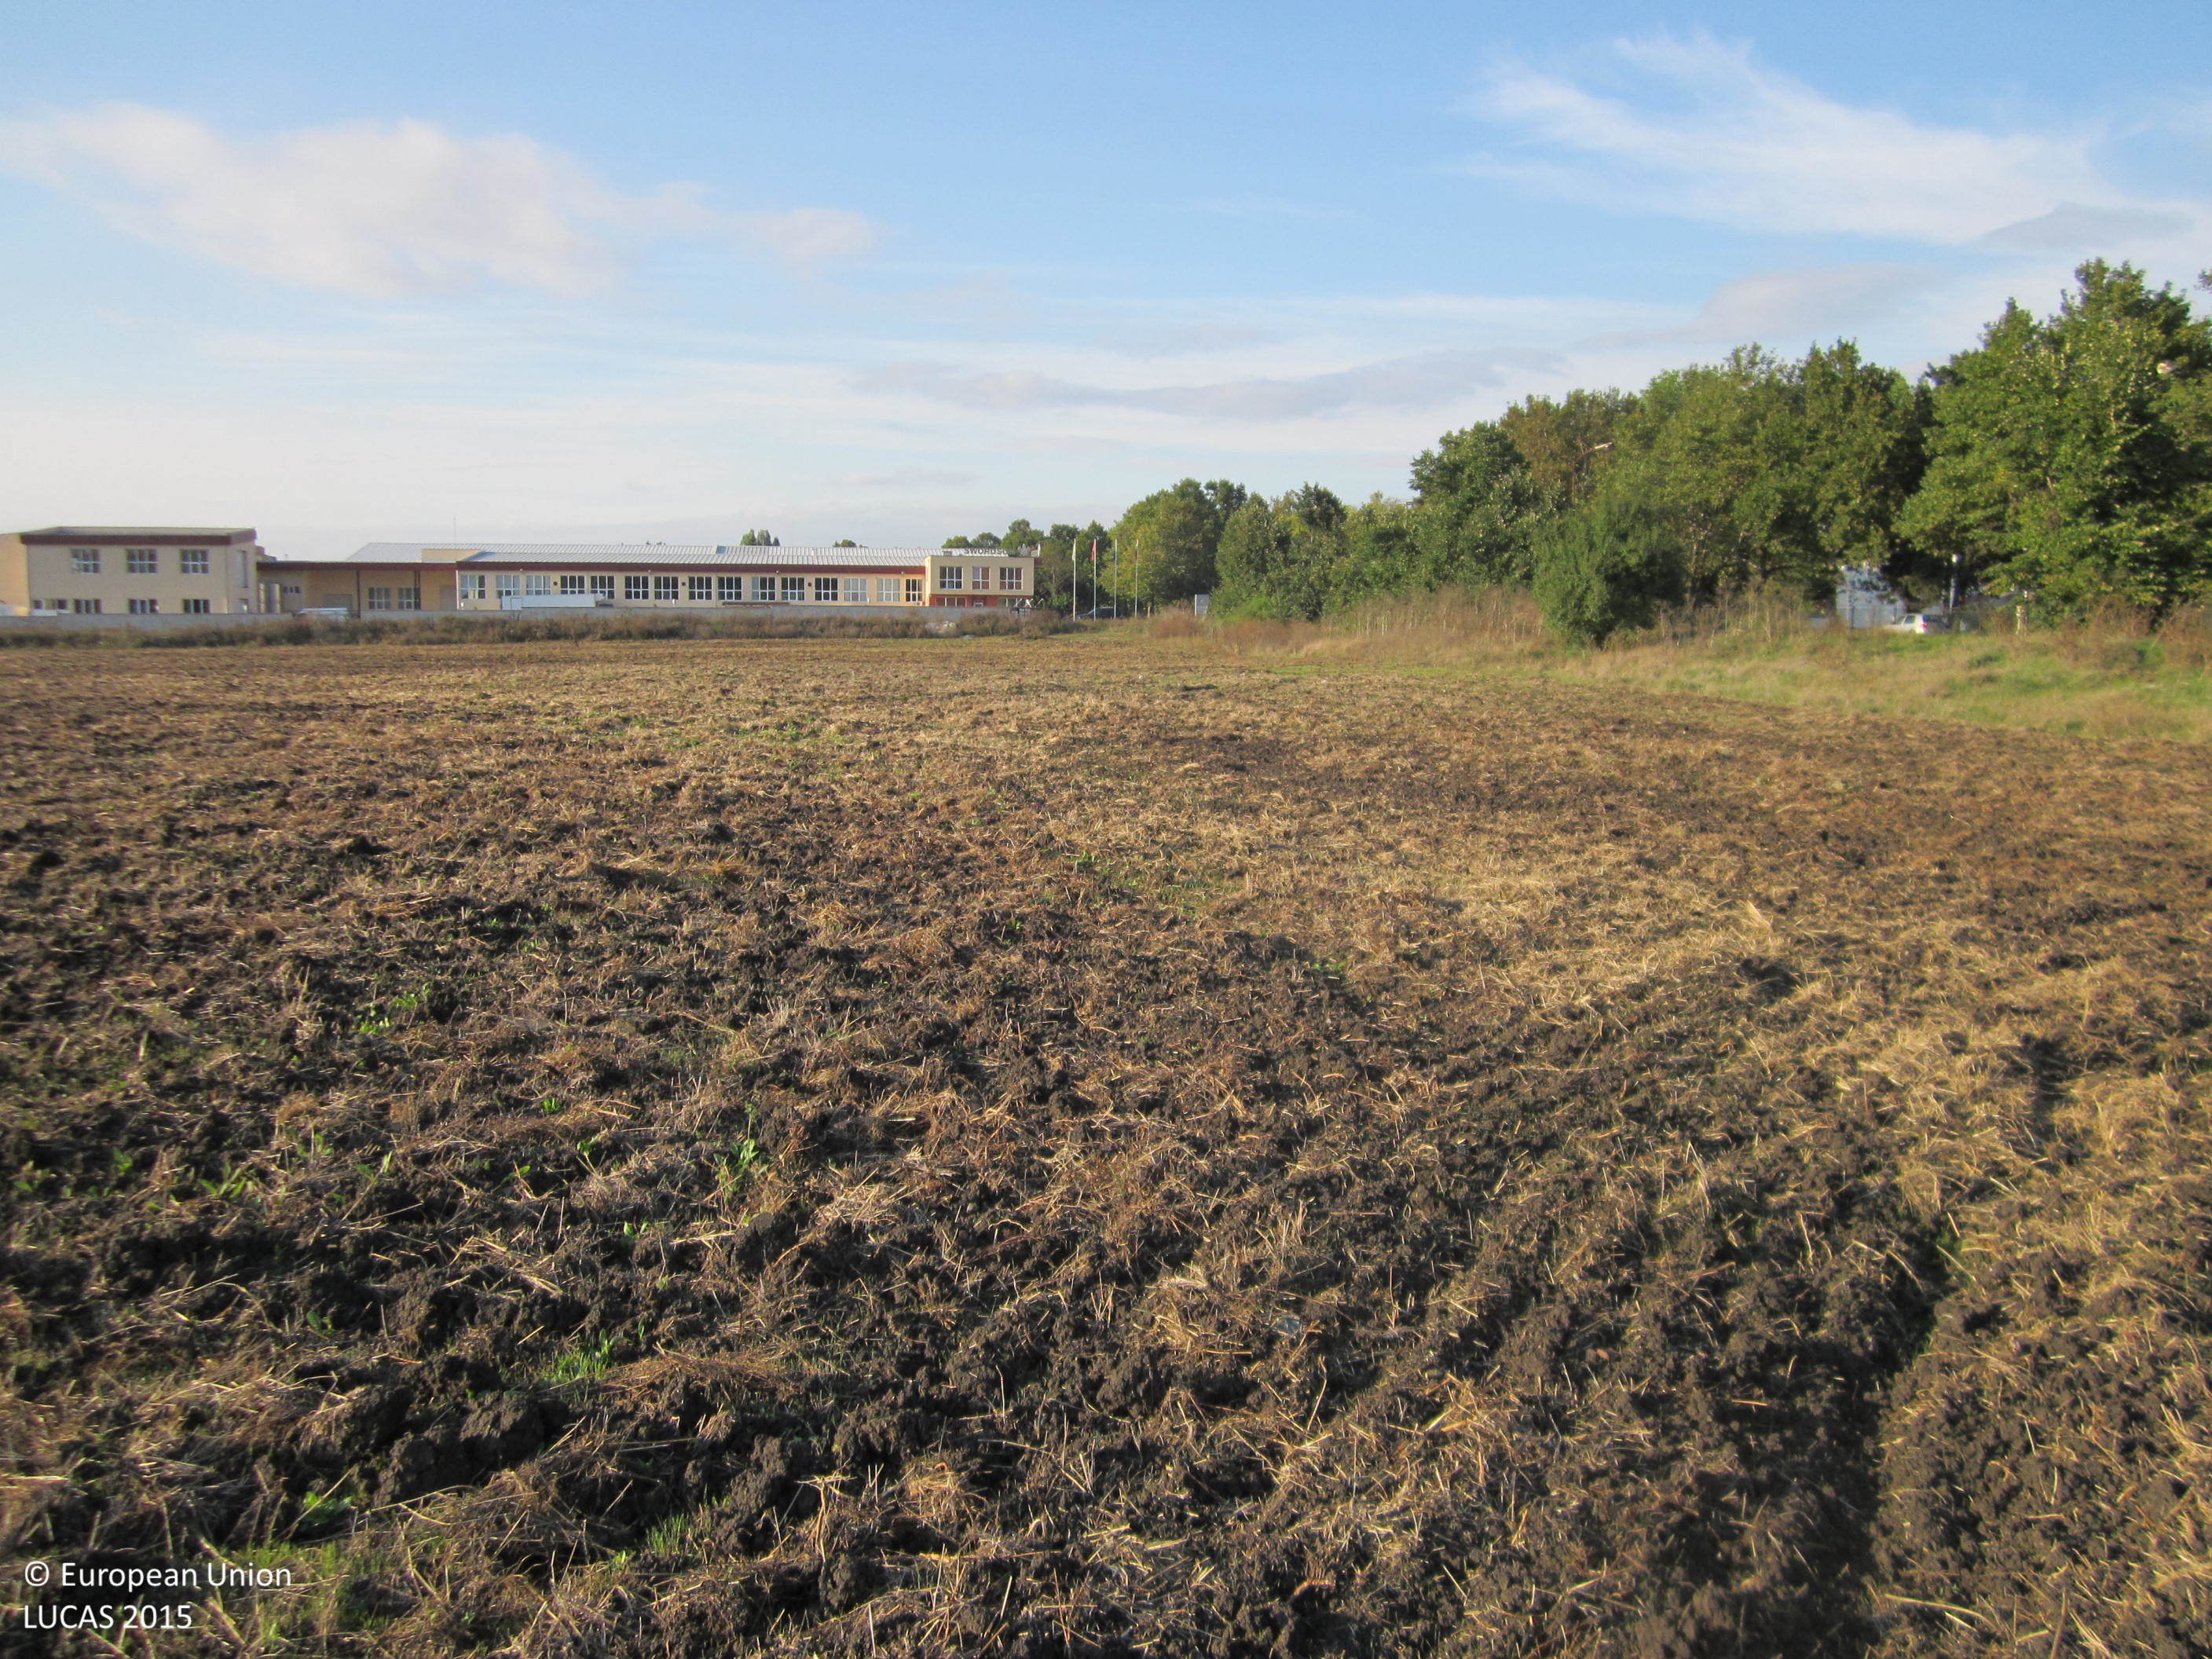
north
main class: Cropland
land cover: Common wheat
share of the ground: < 10 %
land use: Agriculture (excluding fallow land and kitchen gardens)
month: October
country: BG
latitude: 42.6627
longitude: 26.9791
